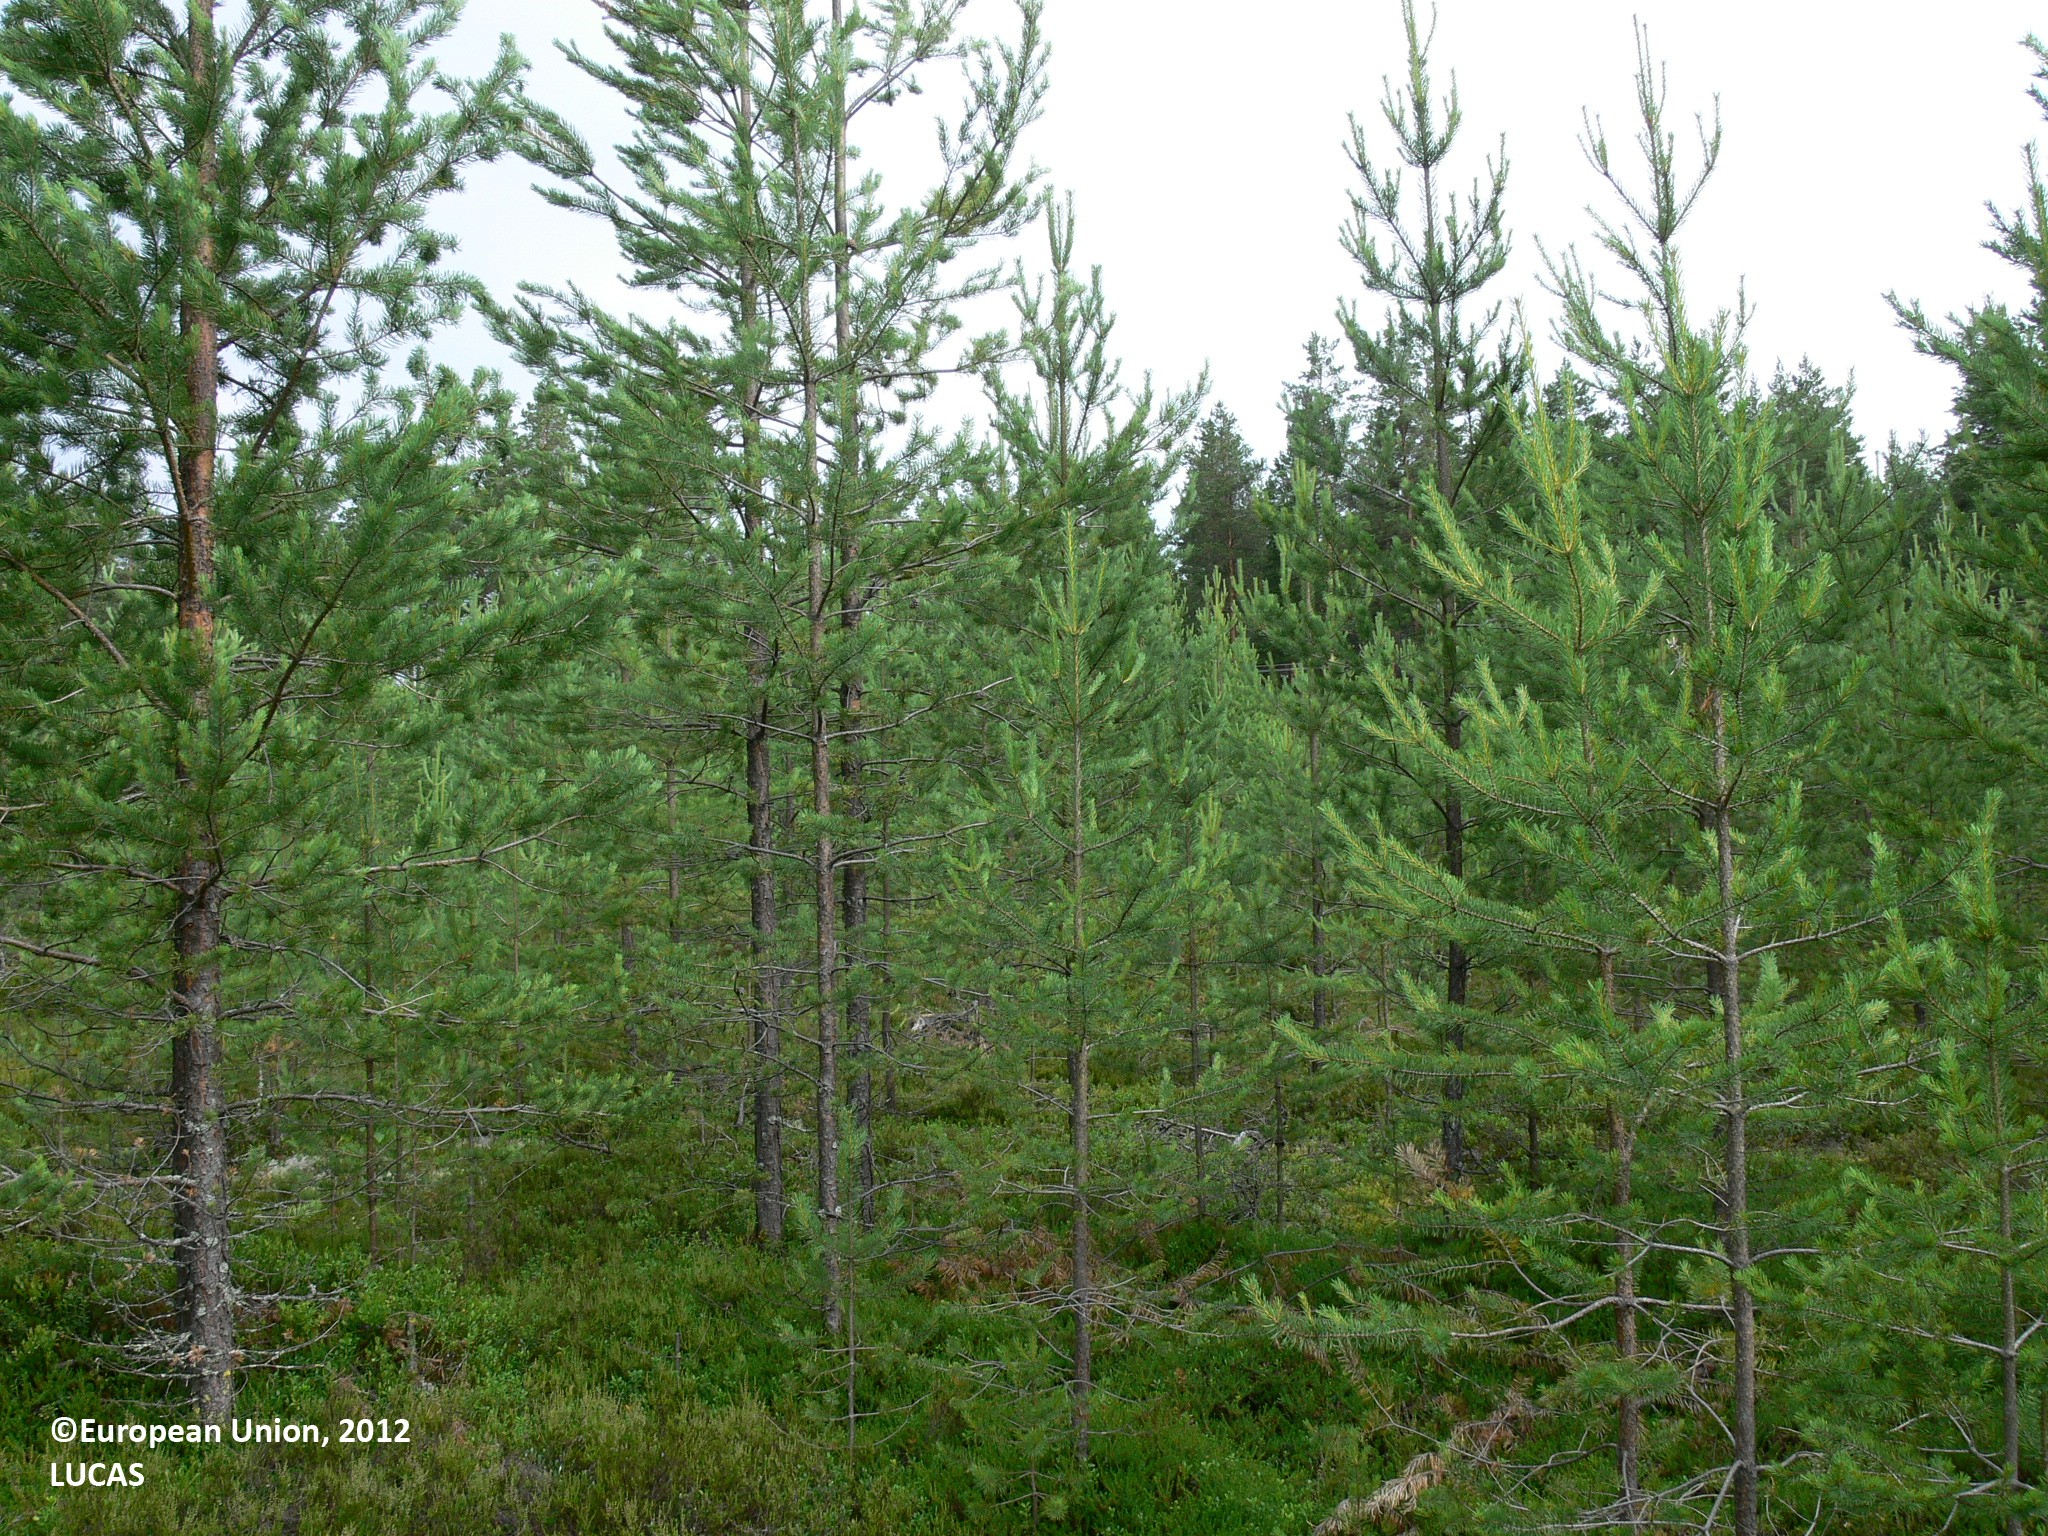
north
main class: Woodland
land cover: Pine dominated coniferous woodland
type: boreal forest
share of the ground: 25 - 50 %
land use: Forestry
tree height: < 5 m
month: July
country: FI
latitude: 63.0835
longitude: 29.9938
